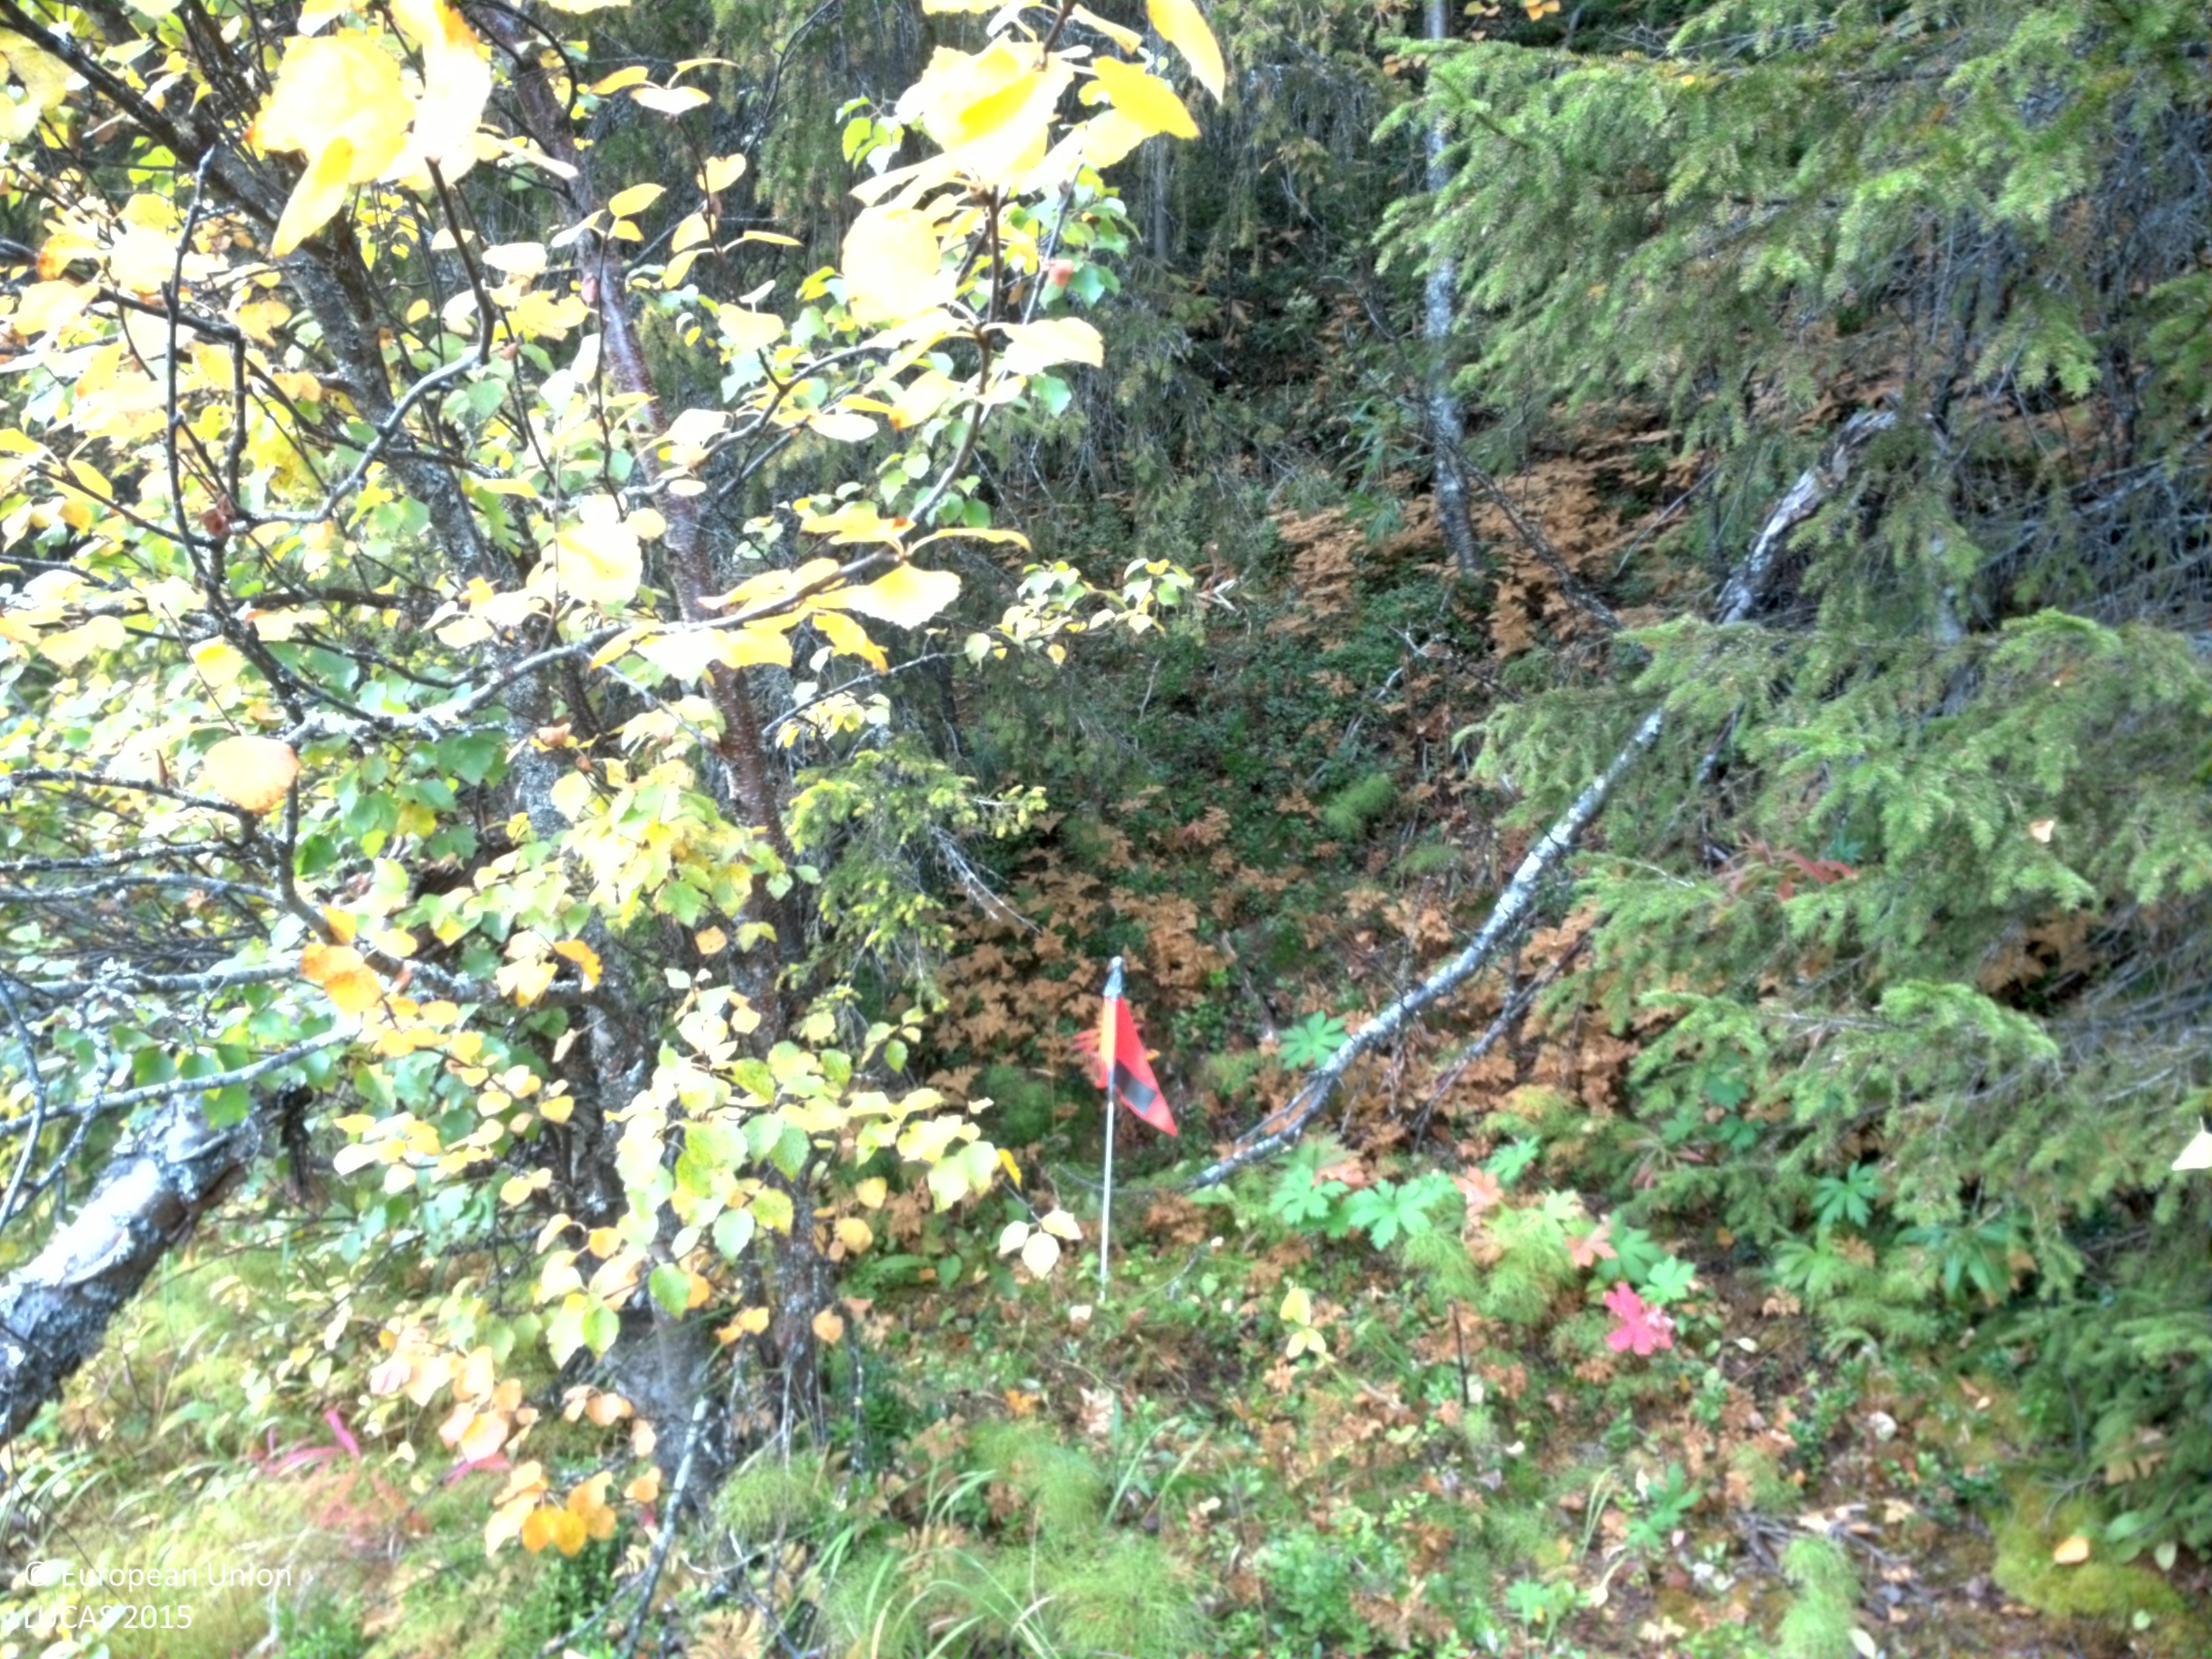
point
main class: Woodland
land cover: Spruce dominated mixed woodland
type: boreal forest
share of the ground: 25 - 50 %
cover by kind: shrubs 40 %, coniferous forest trees 20 %, broadleaved forest trees 15 %, herbaceous plants 15 %, lichens and mosses 10 %
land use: Forestry
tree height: > 5 m
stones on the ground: < 10 %
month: September
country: SE
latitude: 65.2828
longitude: 16.8851
